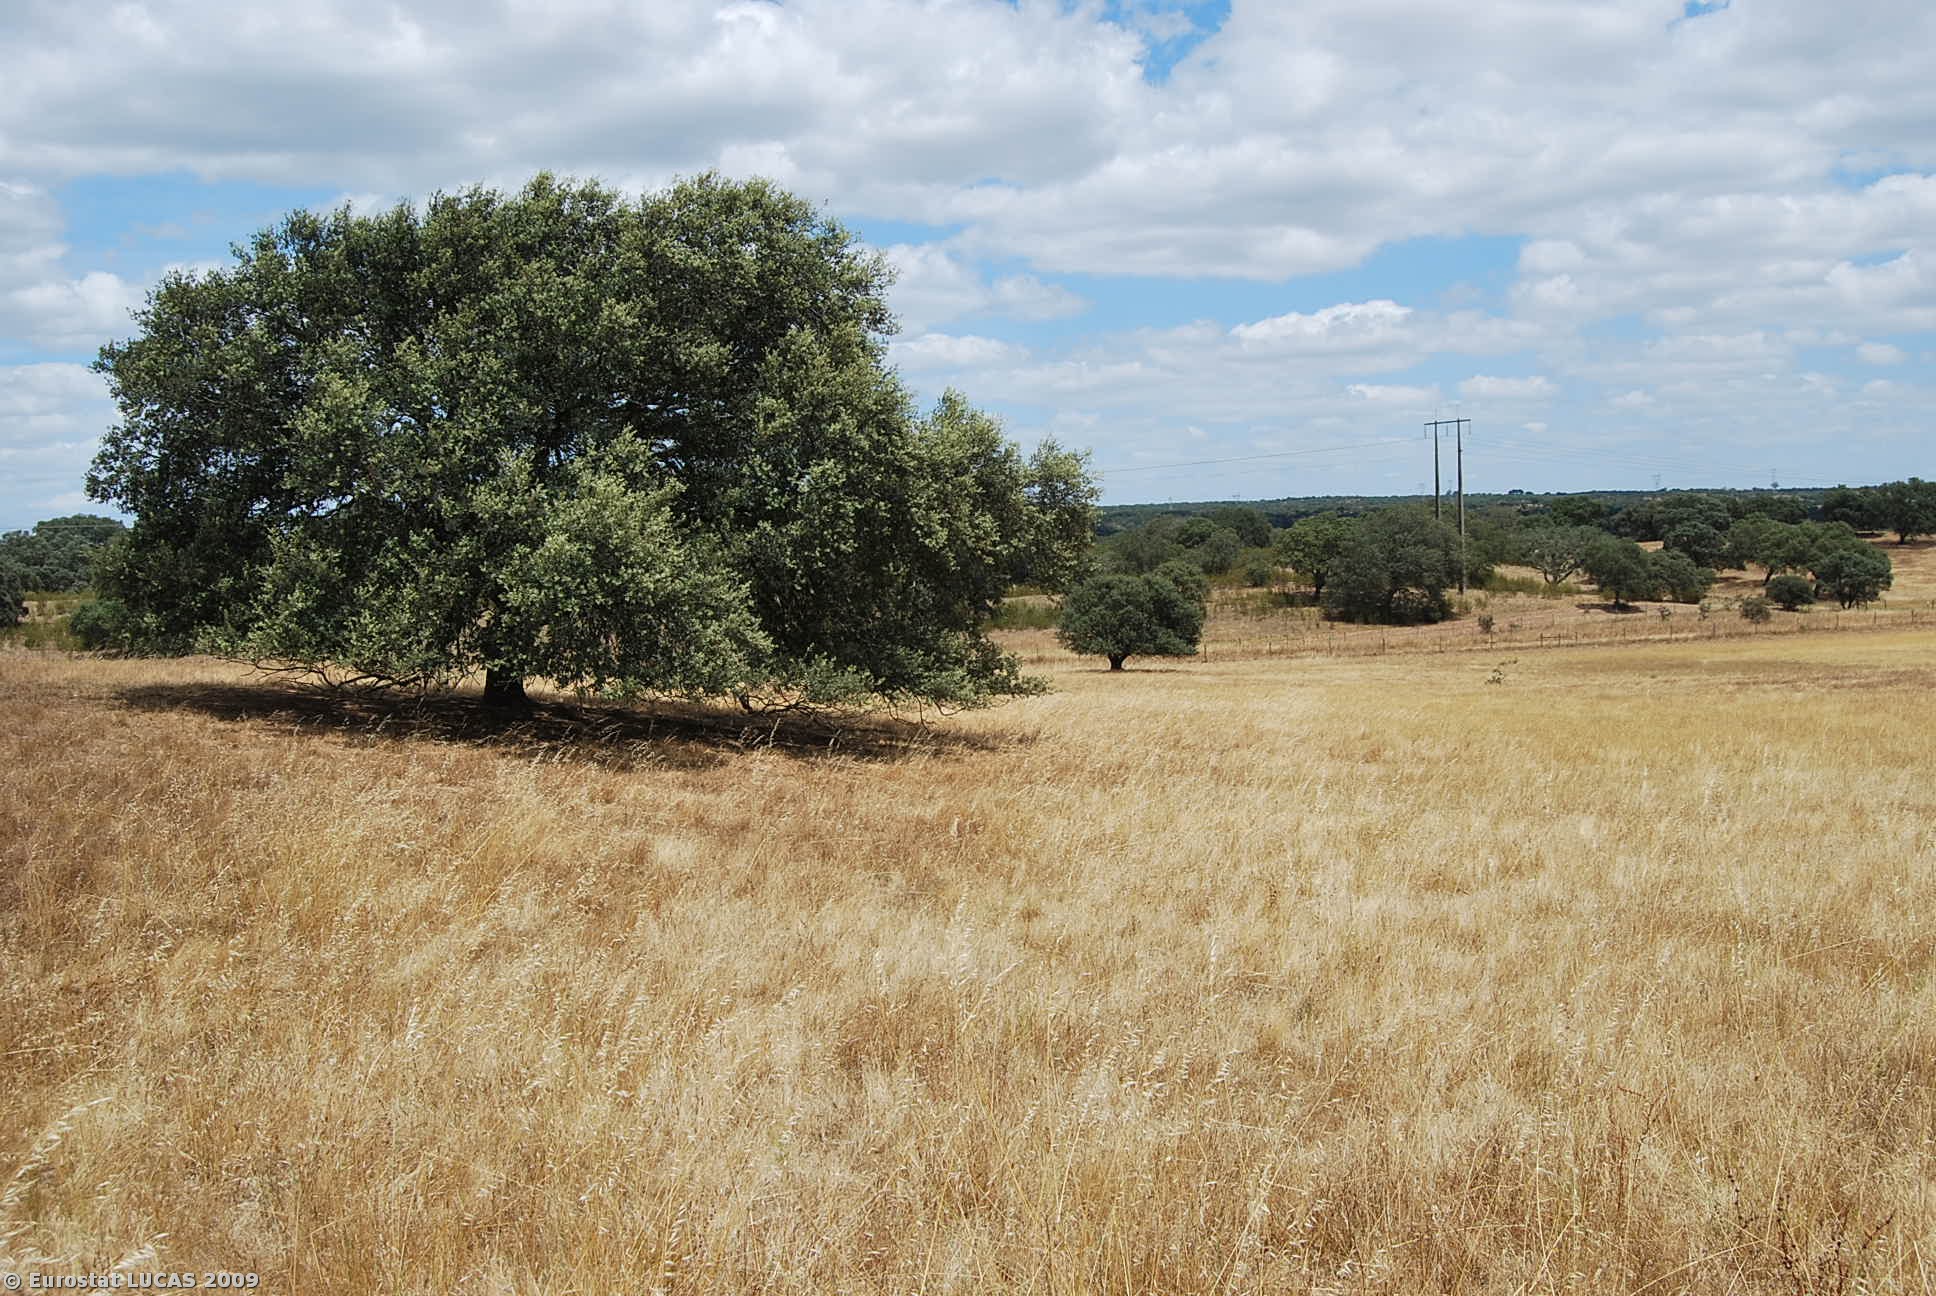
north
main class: Grassland
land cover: Grassland without tree/shrub cover
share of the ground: > 75 %
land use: Agriculture (excluding fallow land and kitchen gardens)
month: June
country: PT
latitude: 37.9950
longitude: -8.5717
